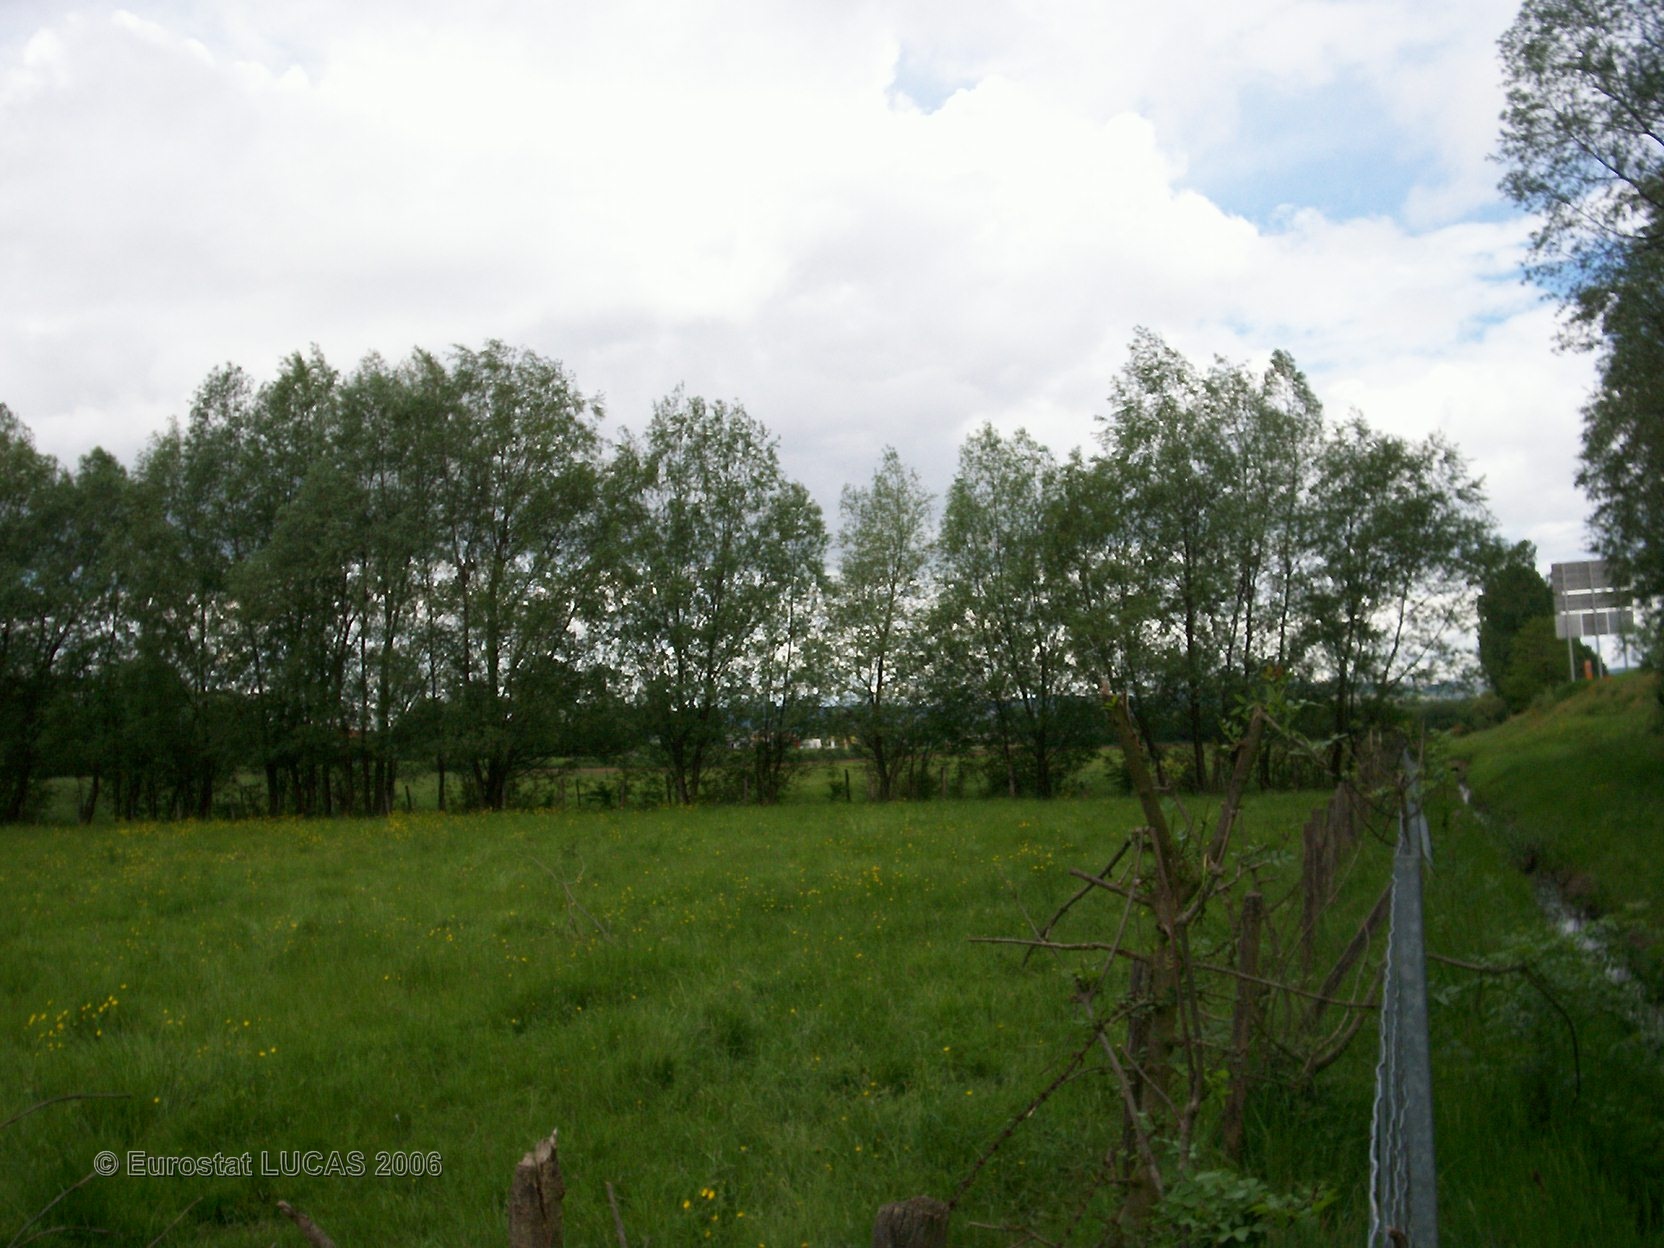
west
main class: Grassland
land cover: Grassland without tree/shrub cover
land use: Agriculture (excluding fallow land and kitchen gardens)
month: May
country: FR
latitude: 45.9170
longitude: 4.7814
